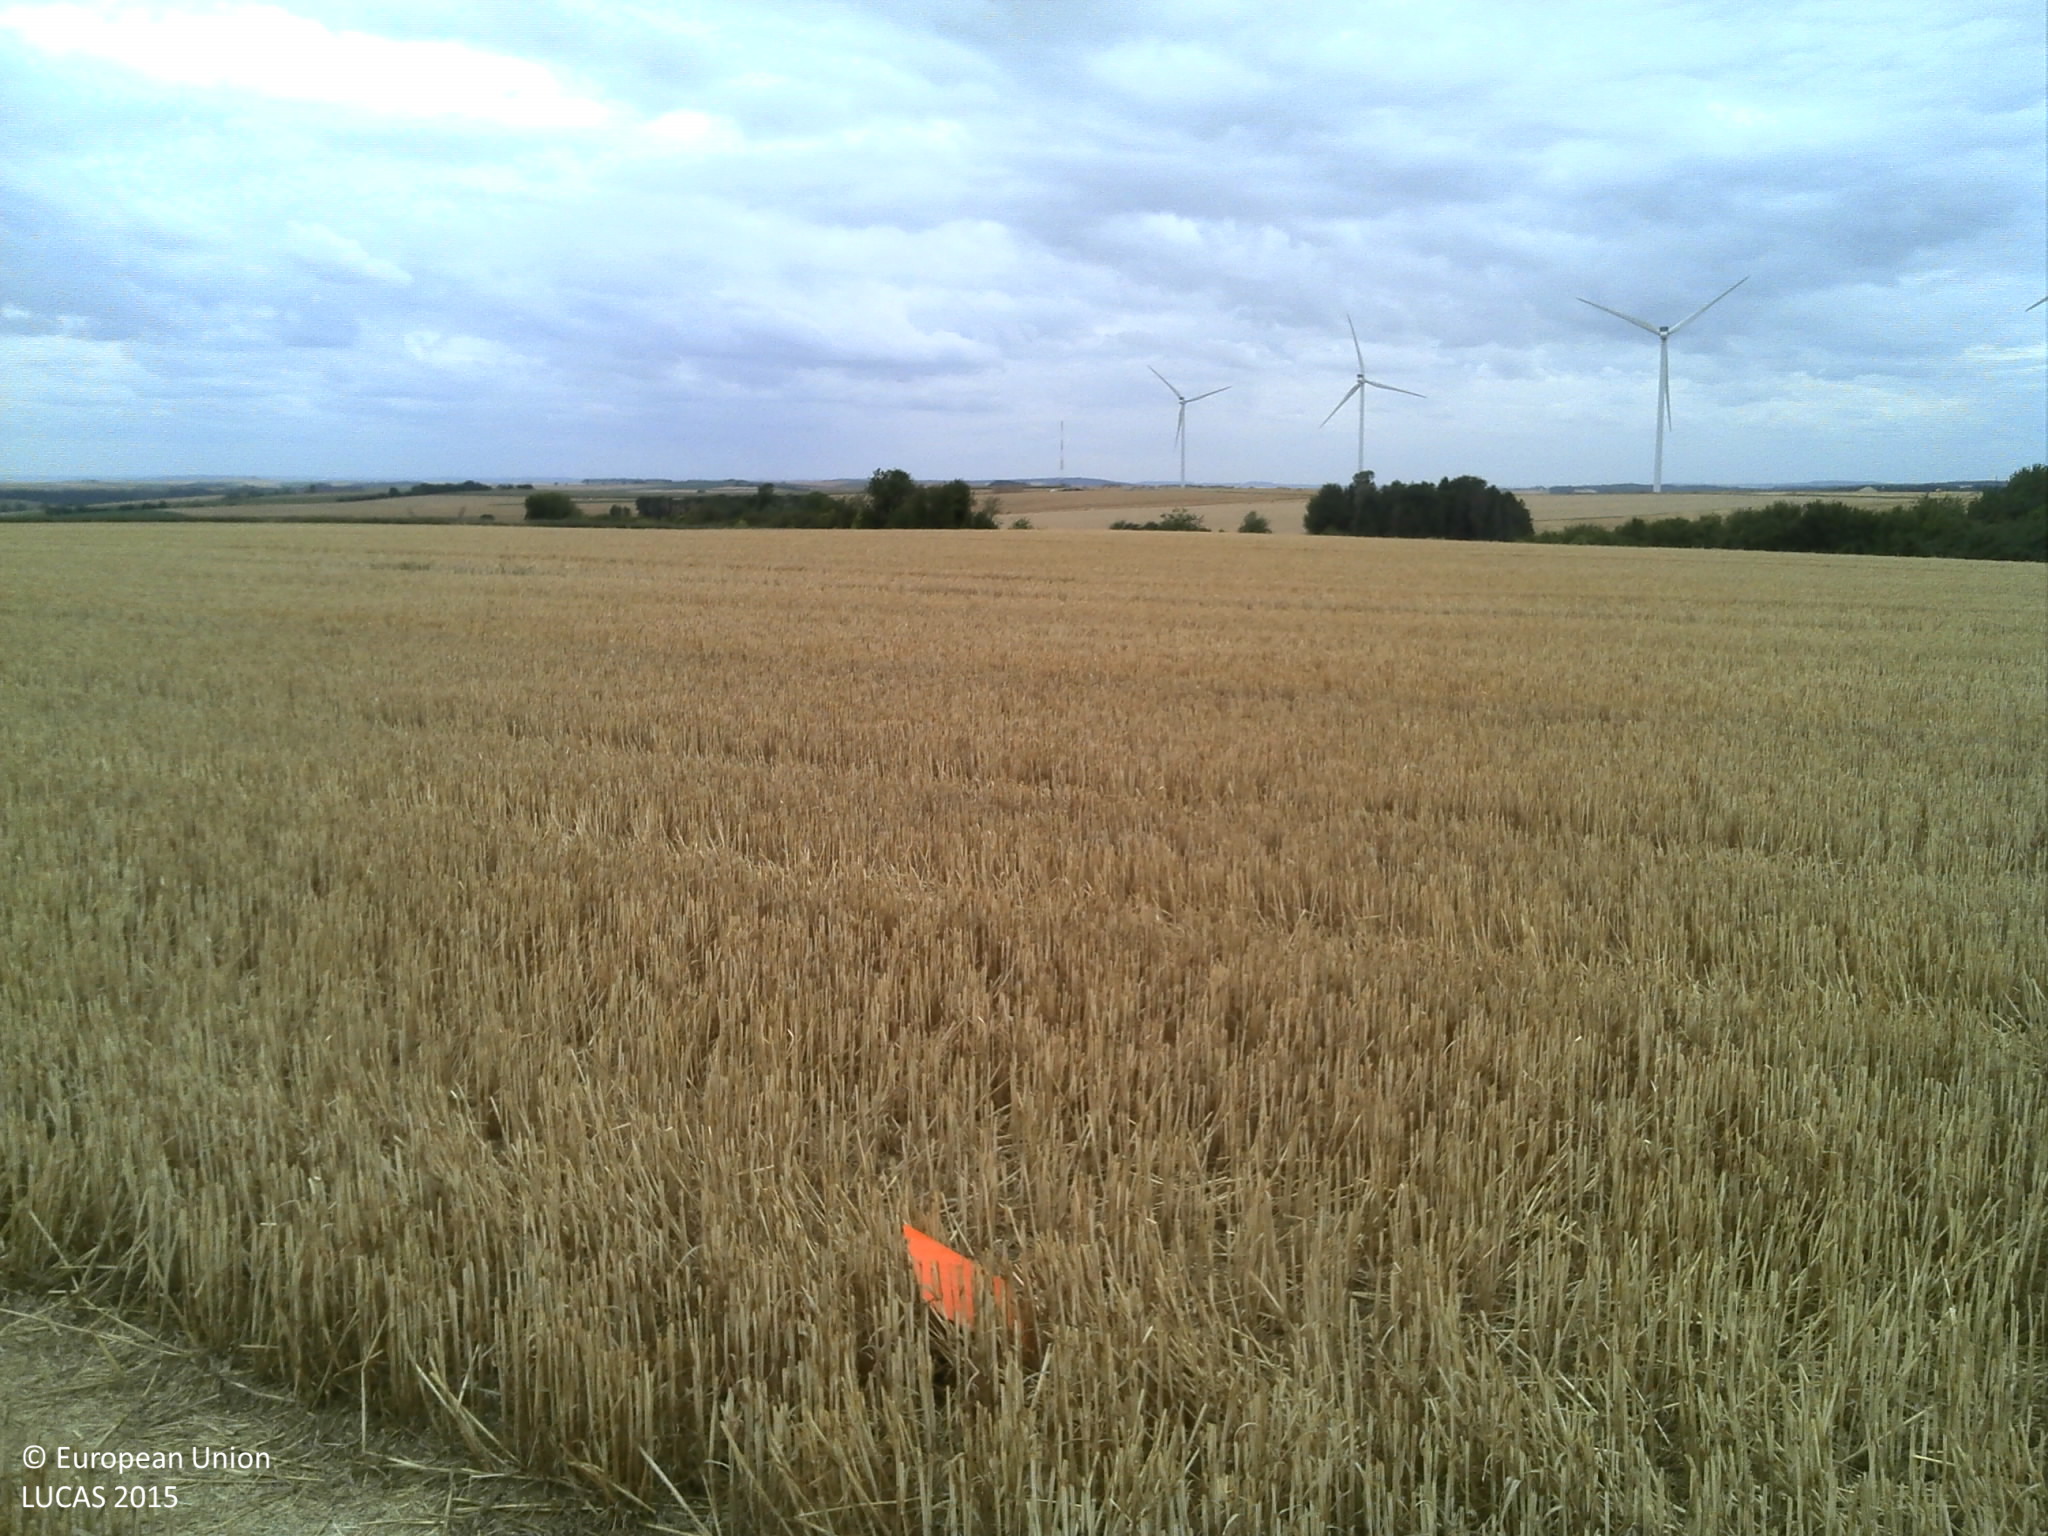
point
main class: Cropland
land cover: Common wheat
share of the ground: 50 - 75 %
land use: Agriculture (excluding fallow land and kitchen gardens)
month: July
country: FR
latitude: 49.5637
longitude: 4.1190
